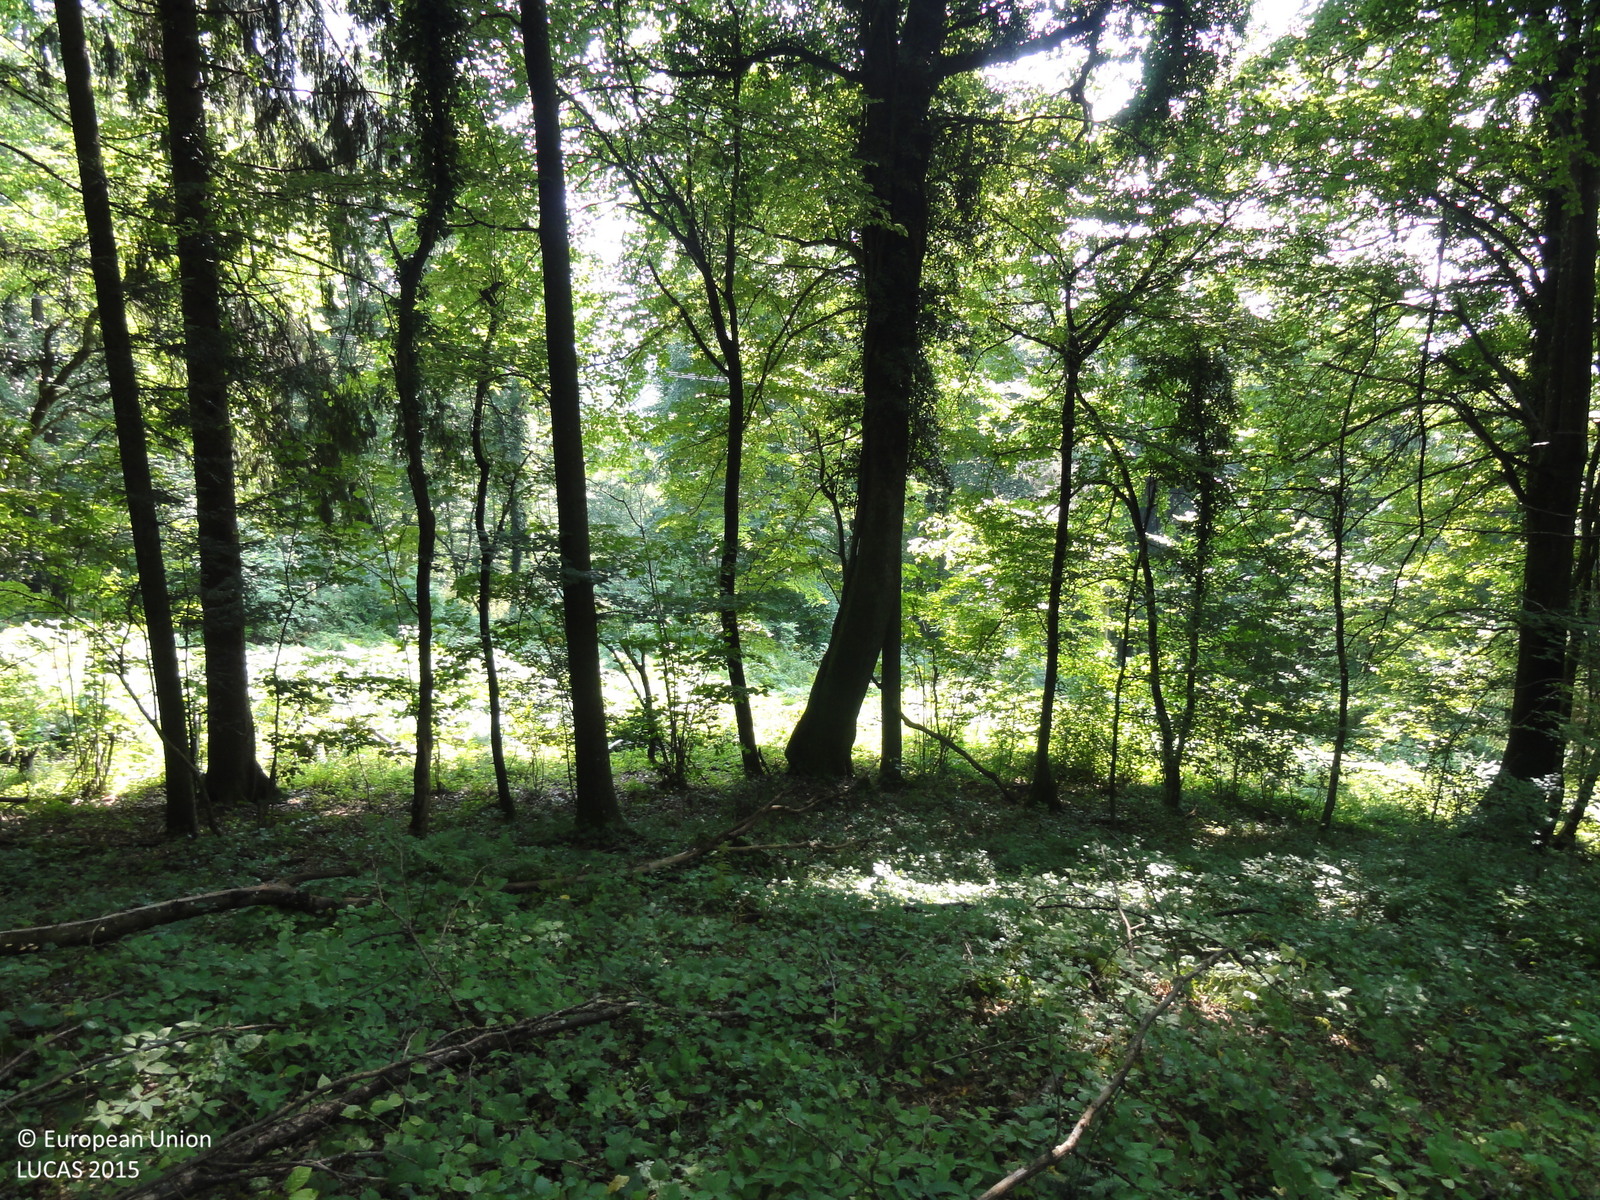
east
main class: Woodland
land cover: Spruce dominated mixed woodland
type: mesophytic deciduous forest
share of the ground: > 75 %
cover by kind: broadleaved forest trees 70 %, coniferous forest trees 30 %
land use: Forestry
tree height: > 5 m
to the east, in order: Spruce dominated mixed woodland; Spontaneously vegetated surfaces; Electric lines; Spontaneously vegetated surfaces; Spruce dominated mixed woodland; Paved roads, cycling and walking lanes; Spontaneously vegetated surfaces; Temporary grasslands; Grass margins; Paved roads, cycling and walking lanes; Shruby margins; Grassland without tree/shrub cover; Abandoned hedges; Grassland with sparse tree/shrub cover; Temporary grasslands
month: August
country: SI
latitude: 45.8451
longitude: 15.2117
